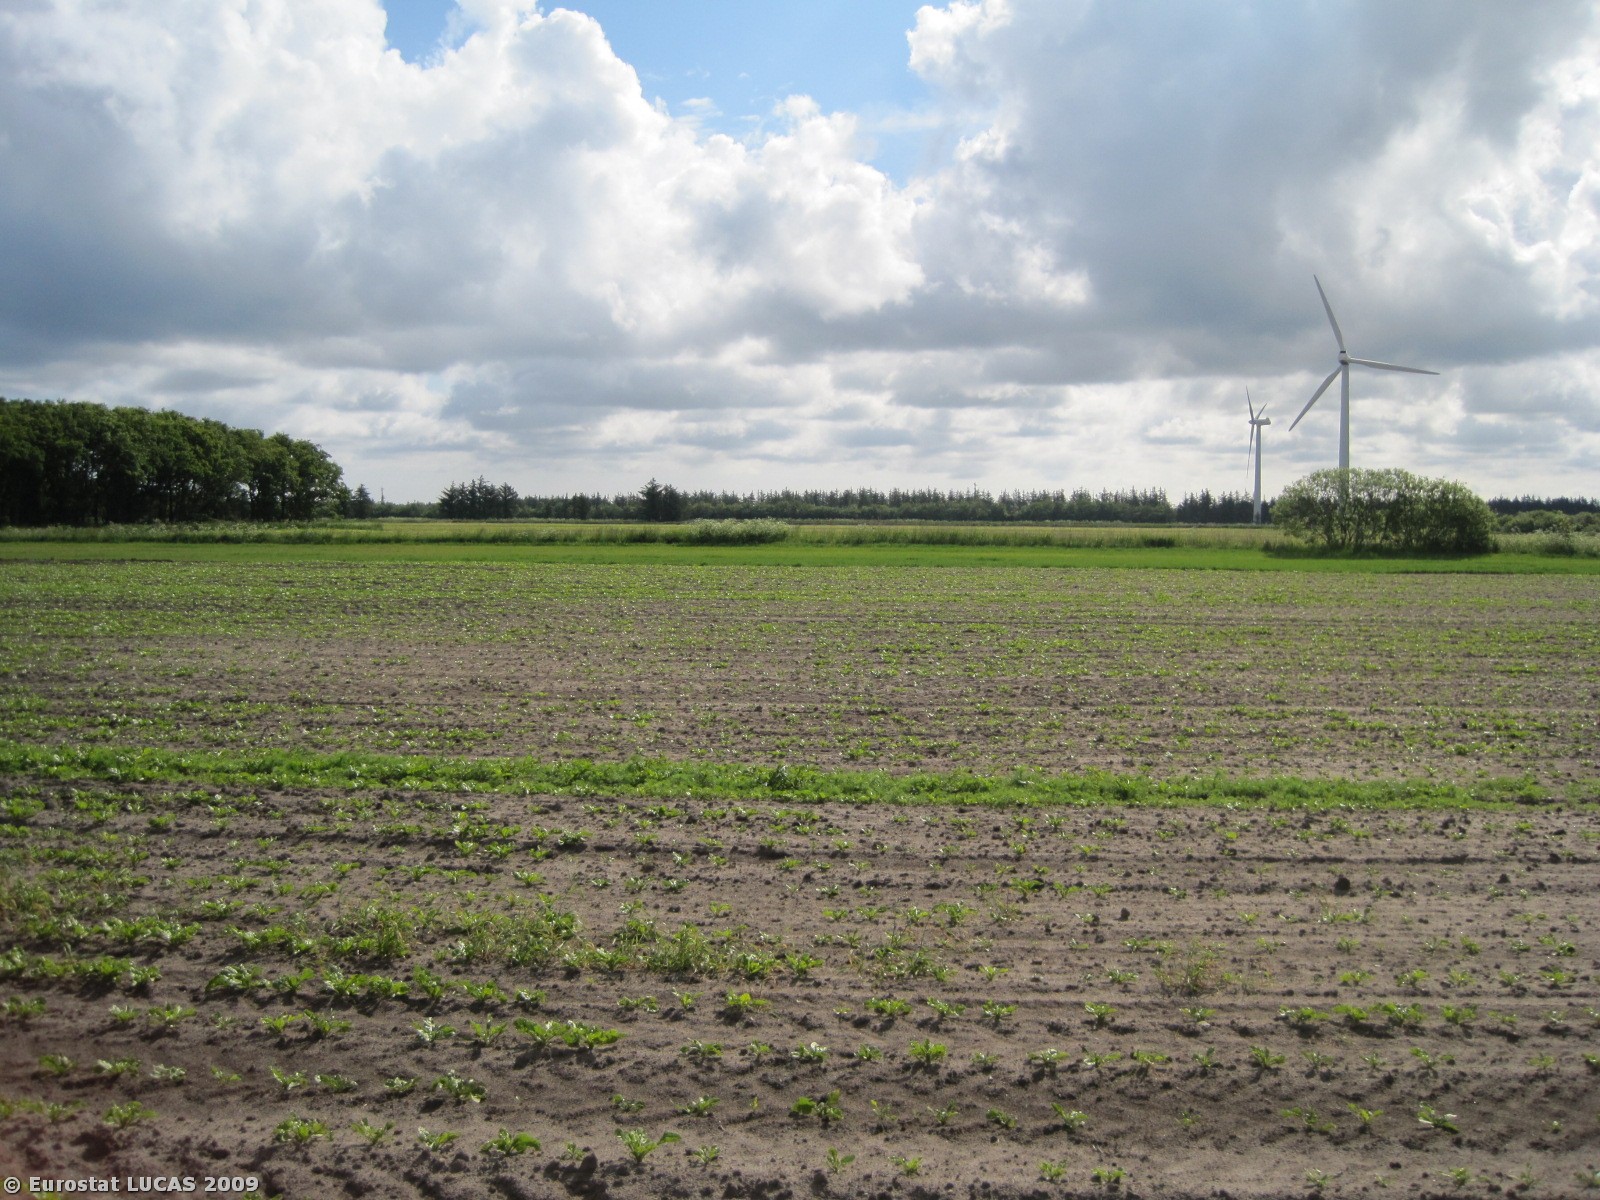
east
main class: Cropland
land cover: Sugar beet
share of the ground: 10 - 25 %
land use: Agriculture (excluding fallow land and kitchen gardens)
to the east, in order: Sugar beet; Barley; Grass margins; Ditches and canals; Grass margins; Tracks; Grass margins; Maize
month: June
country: DK
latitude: 57.5720
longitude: 10.1502
